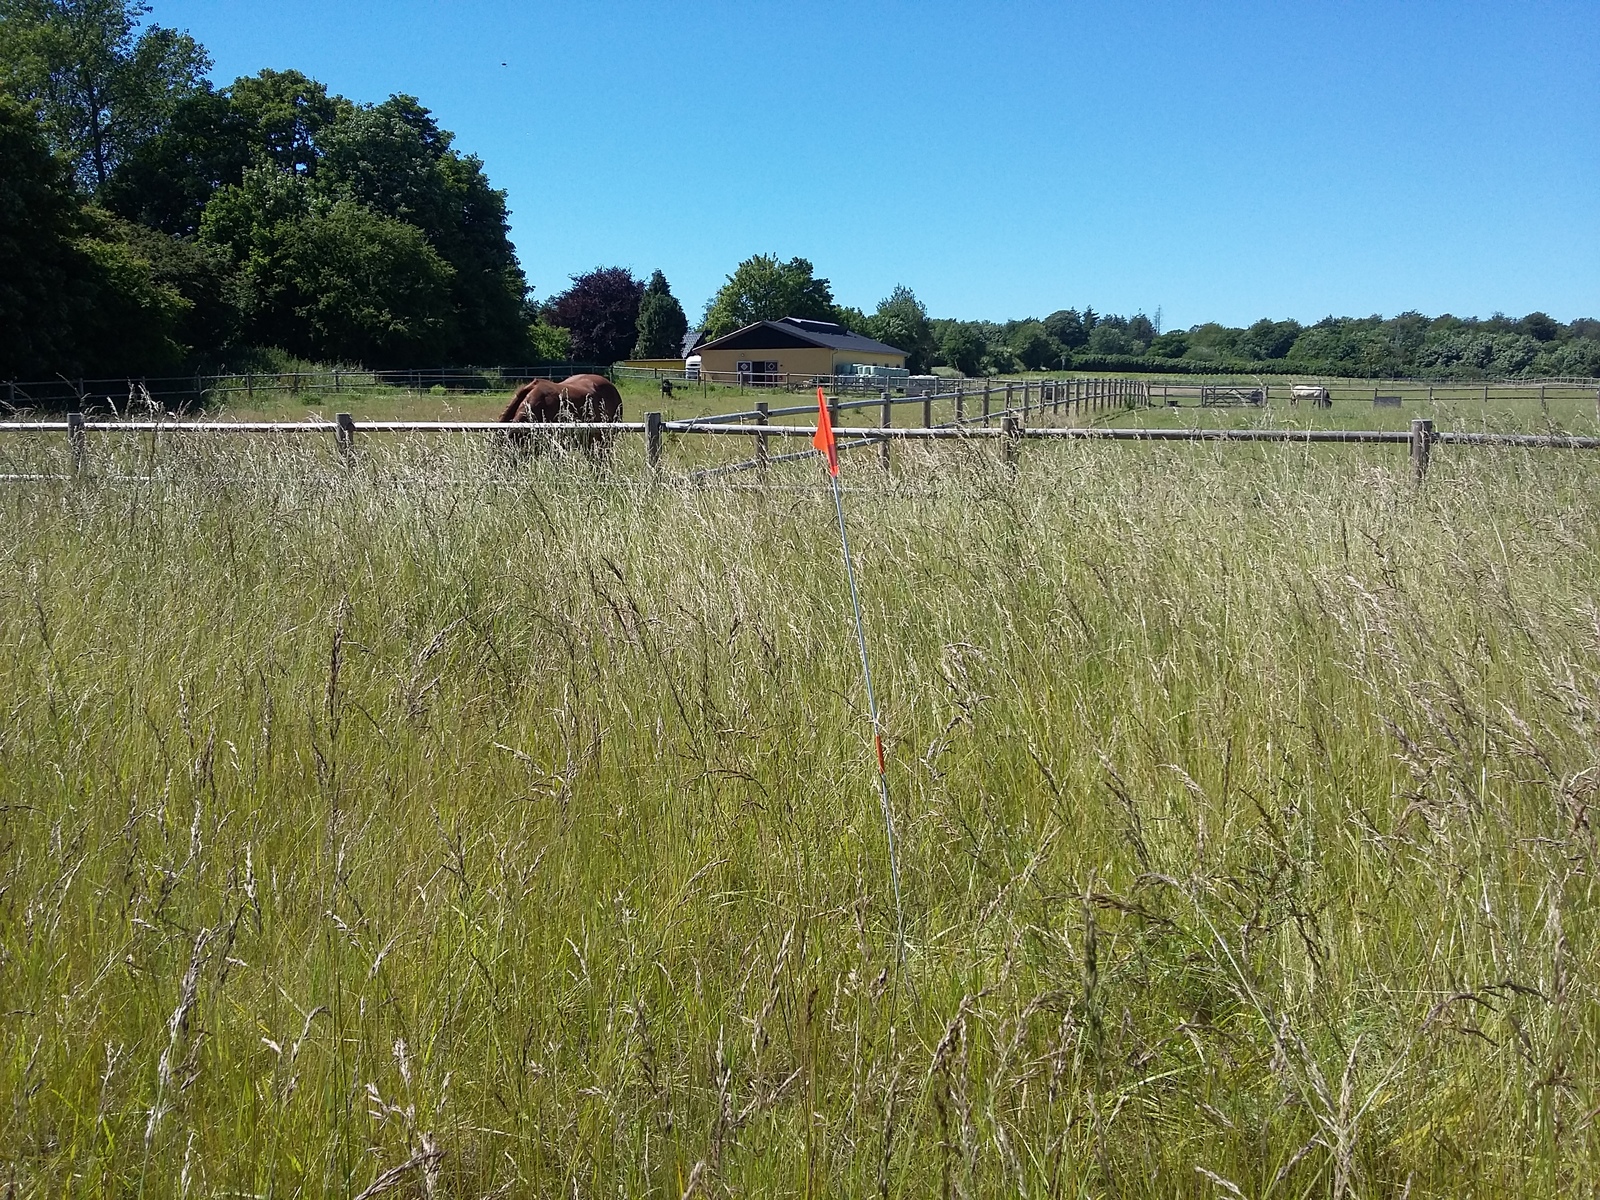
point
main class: Grassland
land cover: Grassland without tree/shrub cover
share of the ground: > 75 %
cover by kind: herbaceous plants 100 %
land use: Agriculture (excluding fallow land and kitchen gardens)
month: July
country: DK
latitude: 55.0930
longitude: 12.0199
